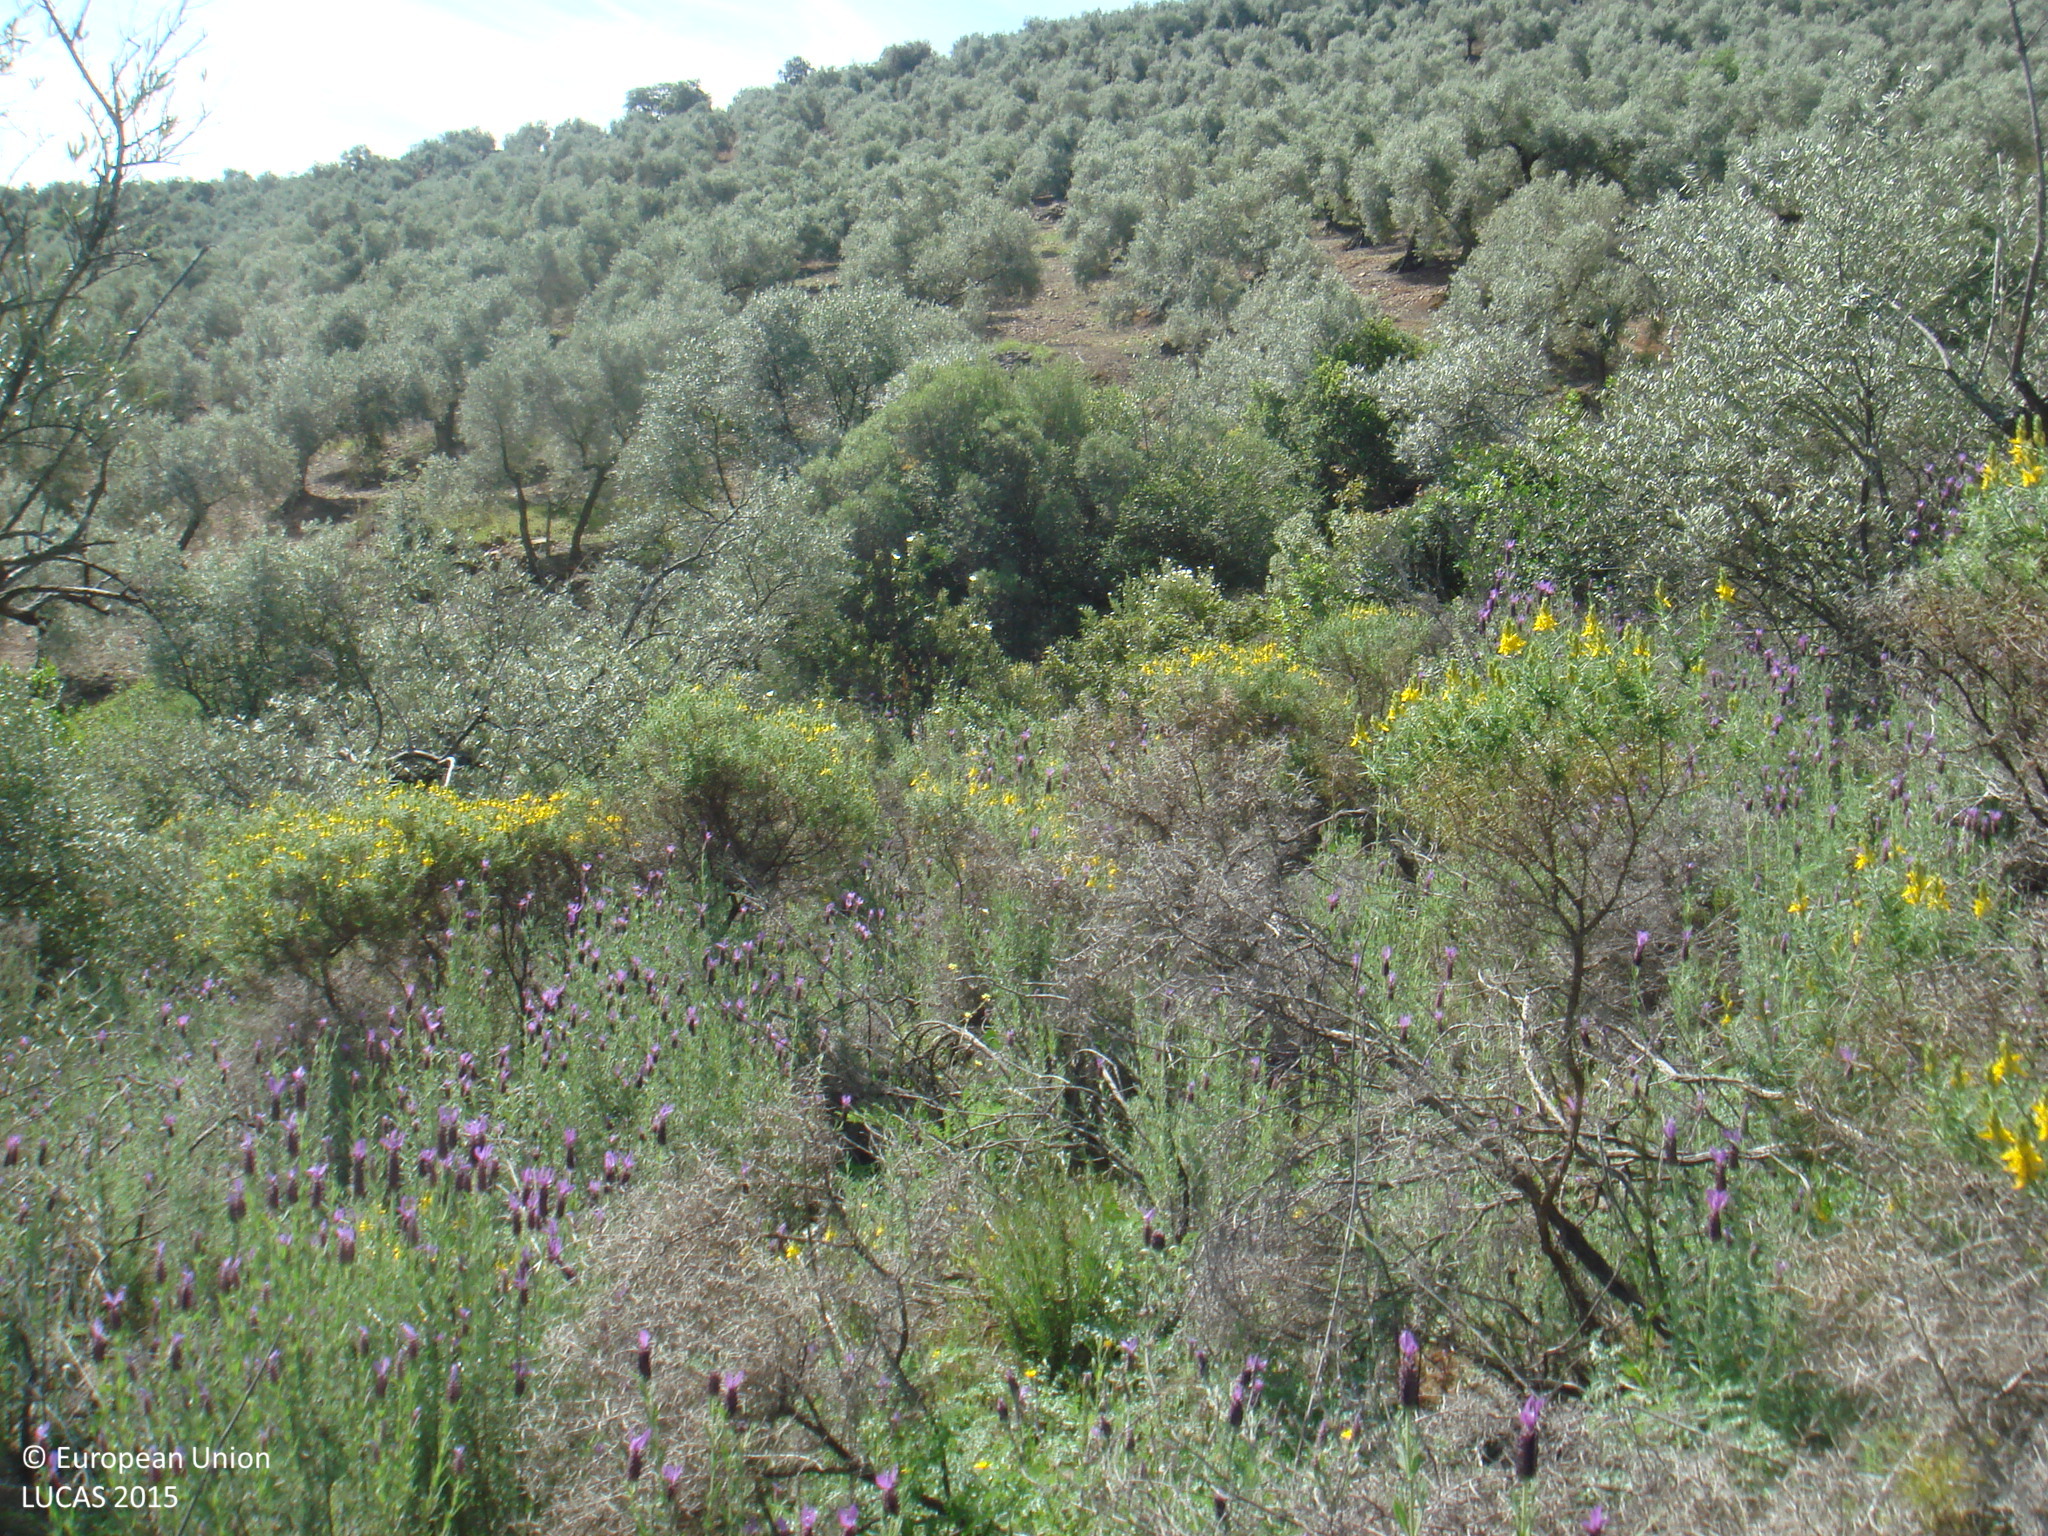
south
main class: Shrubland
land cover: Shrubland with sparse tree cover
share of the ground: > 75 %
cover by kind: shrubs 65 %, herbaceous plants 30 %, broadleaved forest trees 5 %
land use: Agriculture (excluding fallow land and kitchen gardens)
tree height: < 5 m
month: April
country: ES
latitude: 38.0642
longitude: -4.6159
